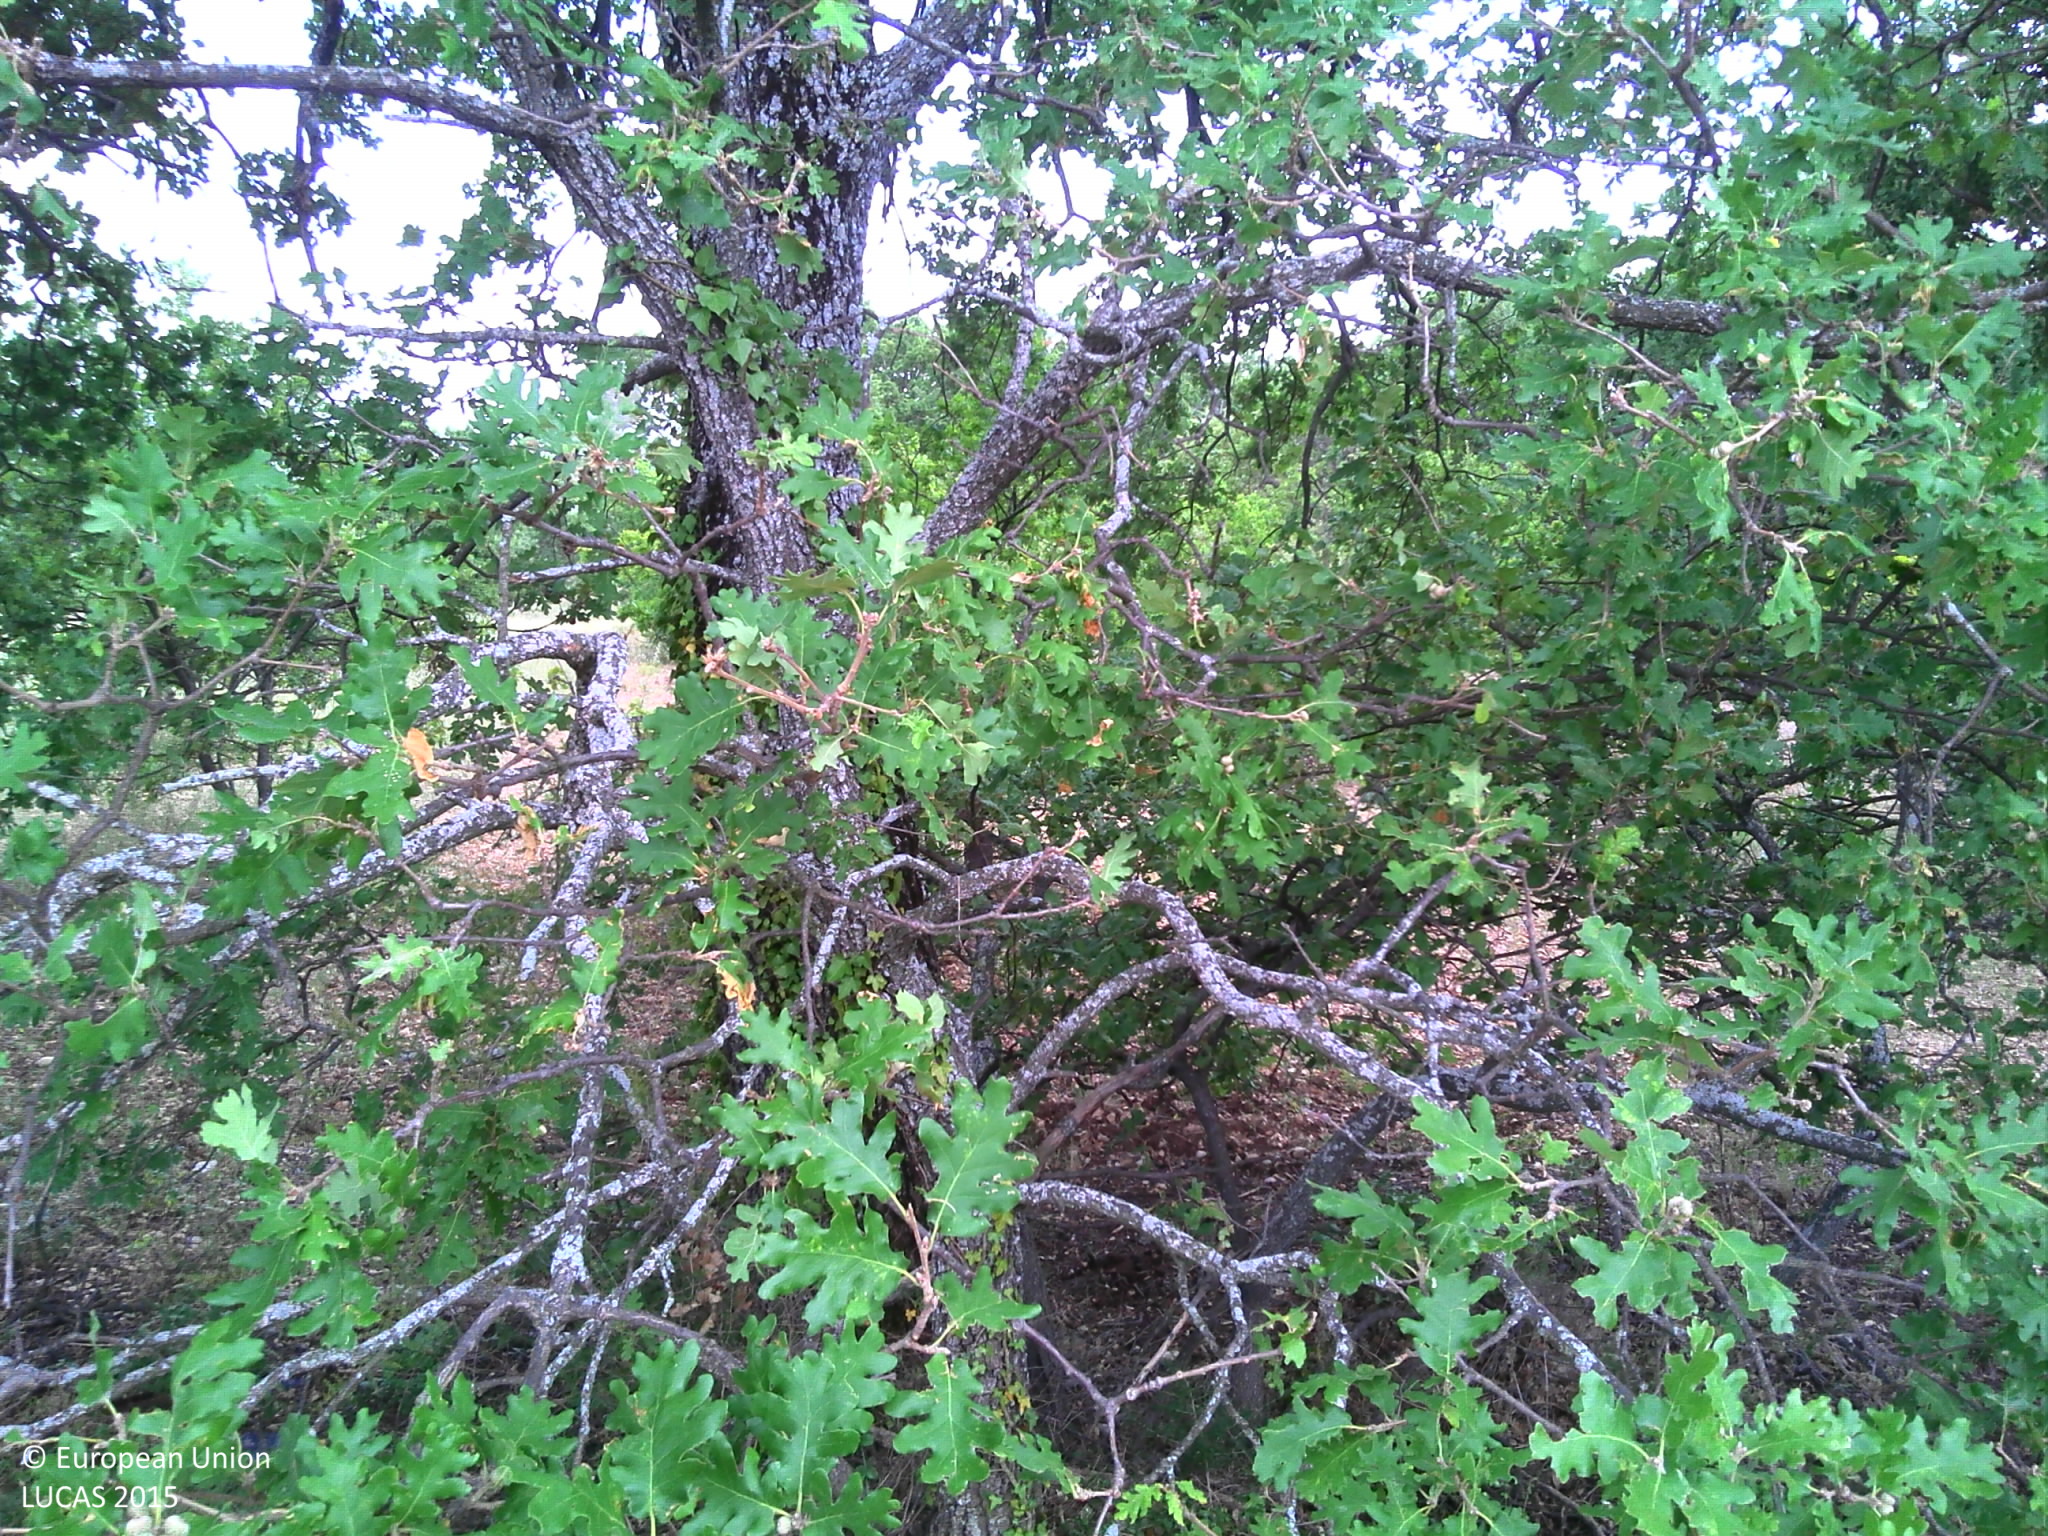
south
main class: Cropland
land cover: Other fresh vegetables
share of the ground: 25 - 50 %
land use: Agriculture (excluding fallow land and kitchen gardens)
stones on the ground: > 50 %
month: July
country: FR
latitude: 43.7799
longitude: 5.4241
